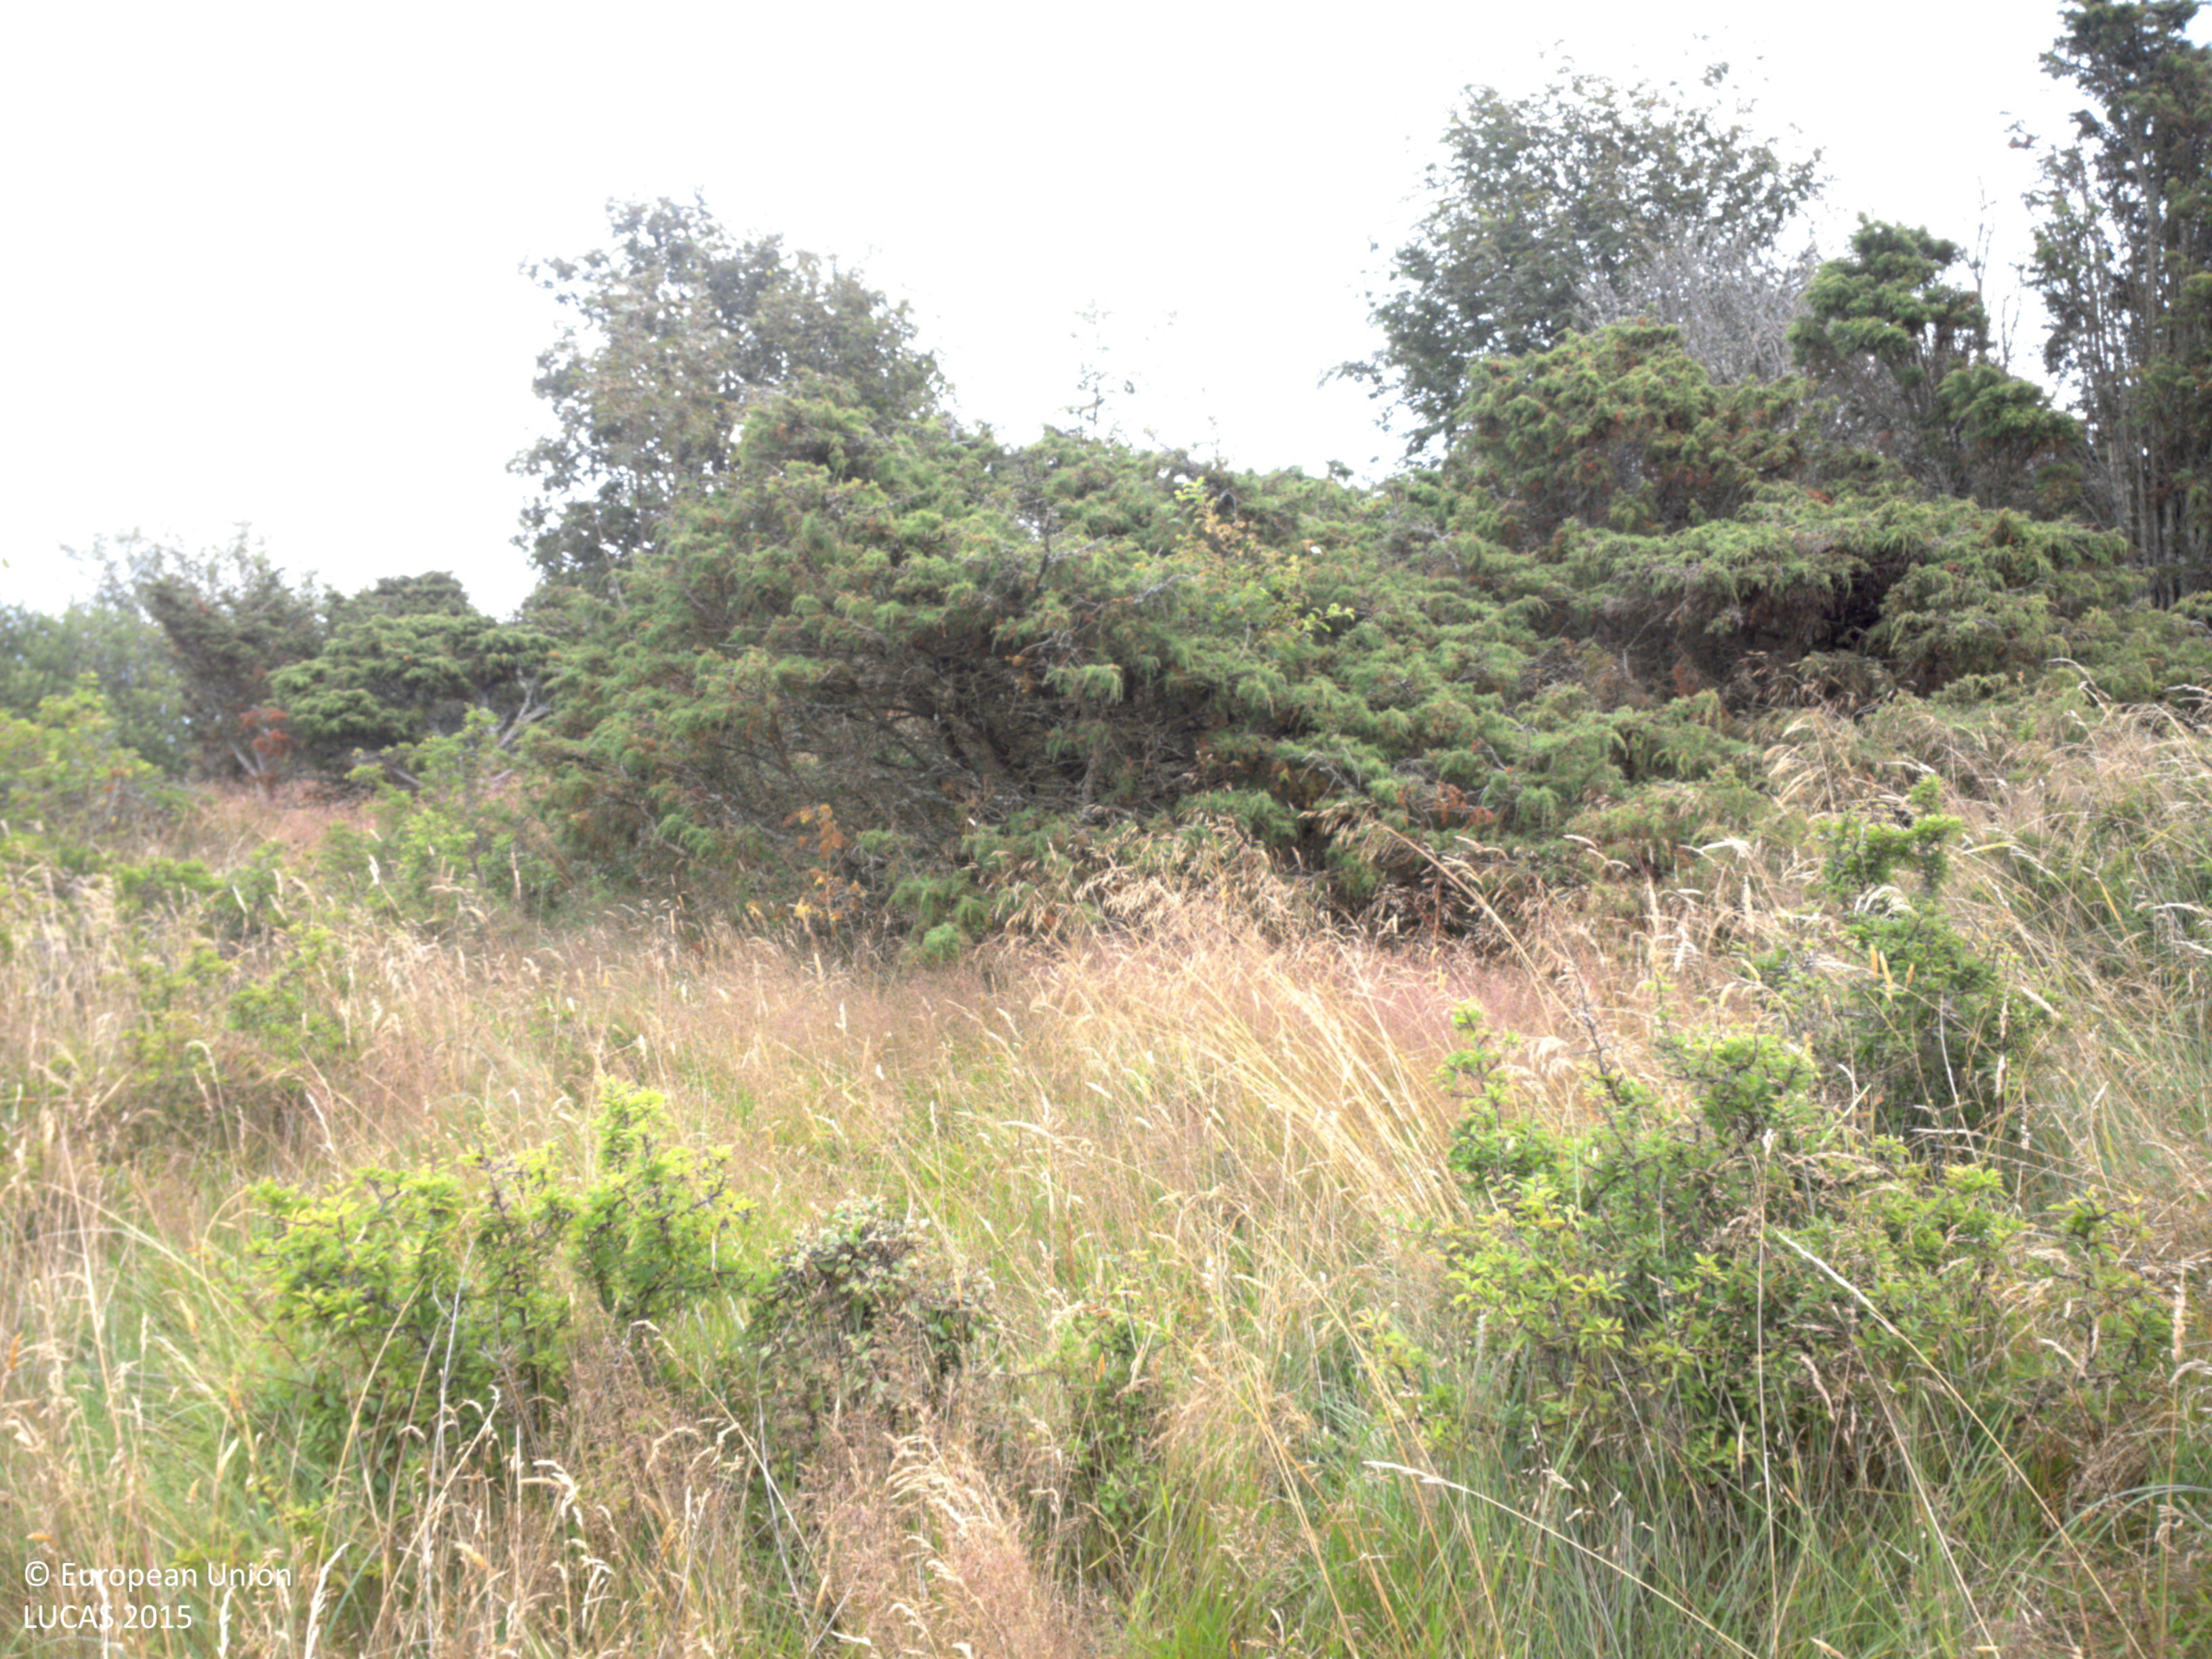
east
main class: Shrubland
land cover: Shrubland without tree cover
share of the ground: 50 - 75 %
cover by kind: shrubs 60 %, herbaceous plants 40 %
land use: Semi-natural and natural areas not in use
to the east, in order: Shrubland without tree cover; Shrubland with sparse tree cover; Broadleaved woodland; Fences; Grassland without tree/shrub cover; Fences; Inland marshes; Electric lines; Inland marshes
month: July
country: SE
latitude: 58.1203
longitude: 11.5757
